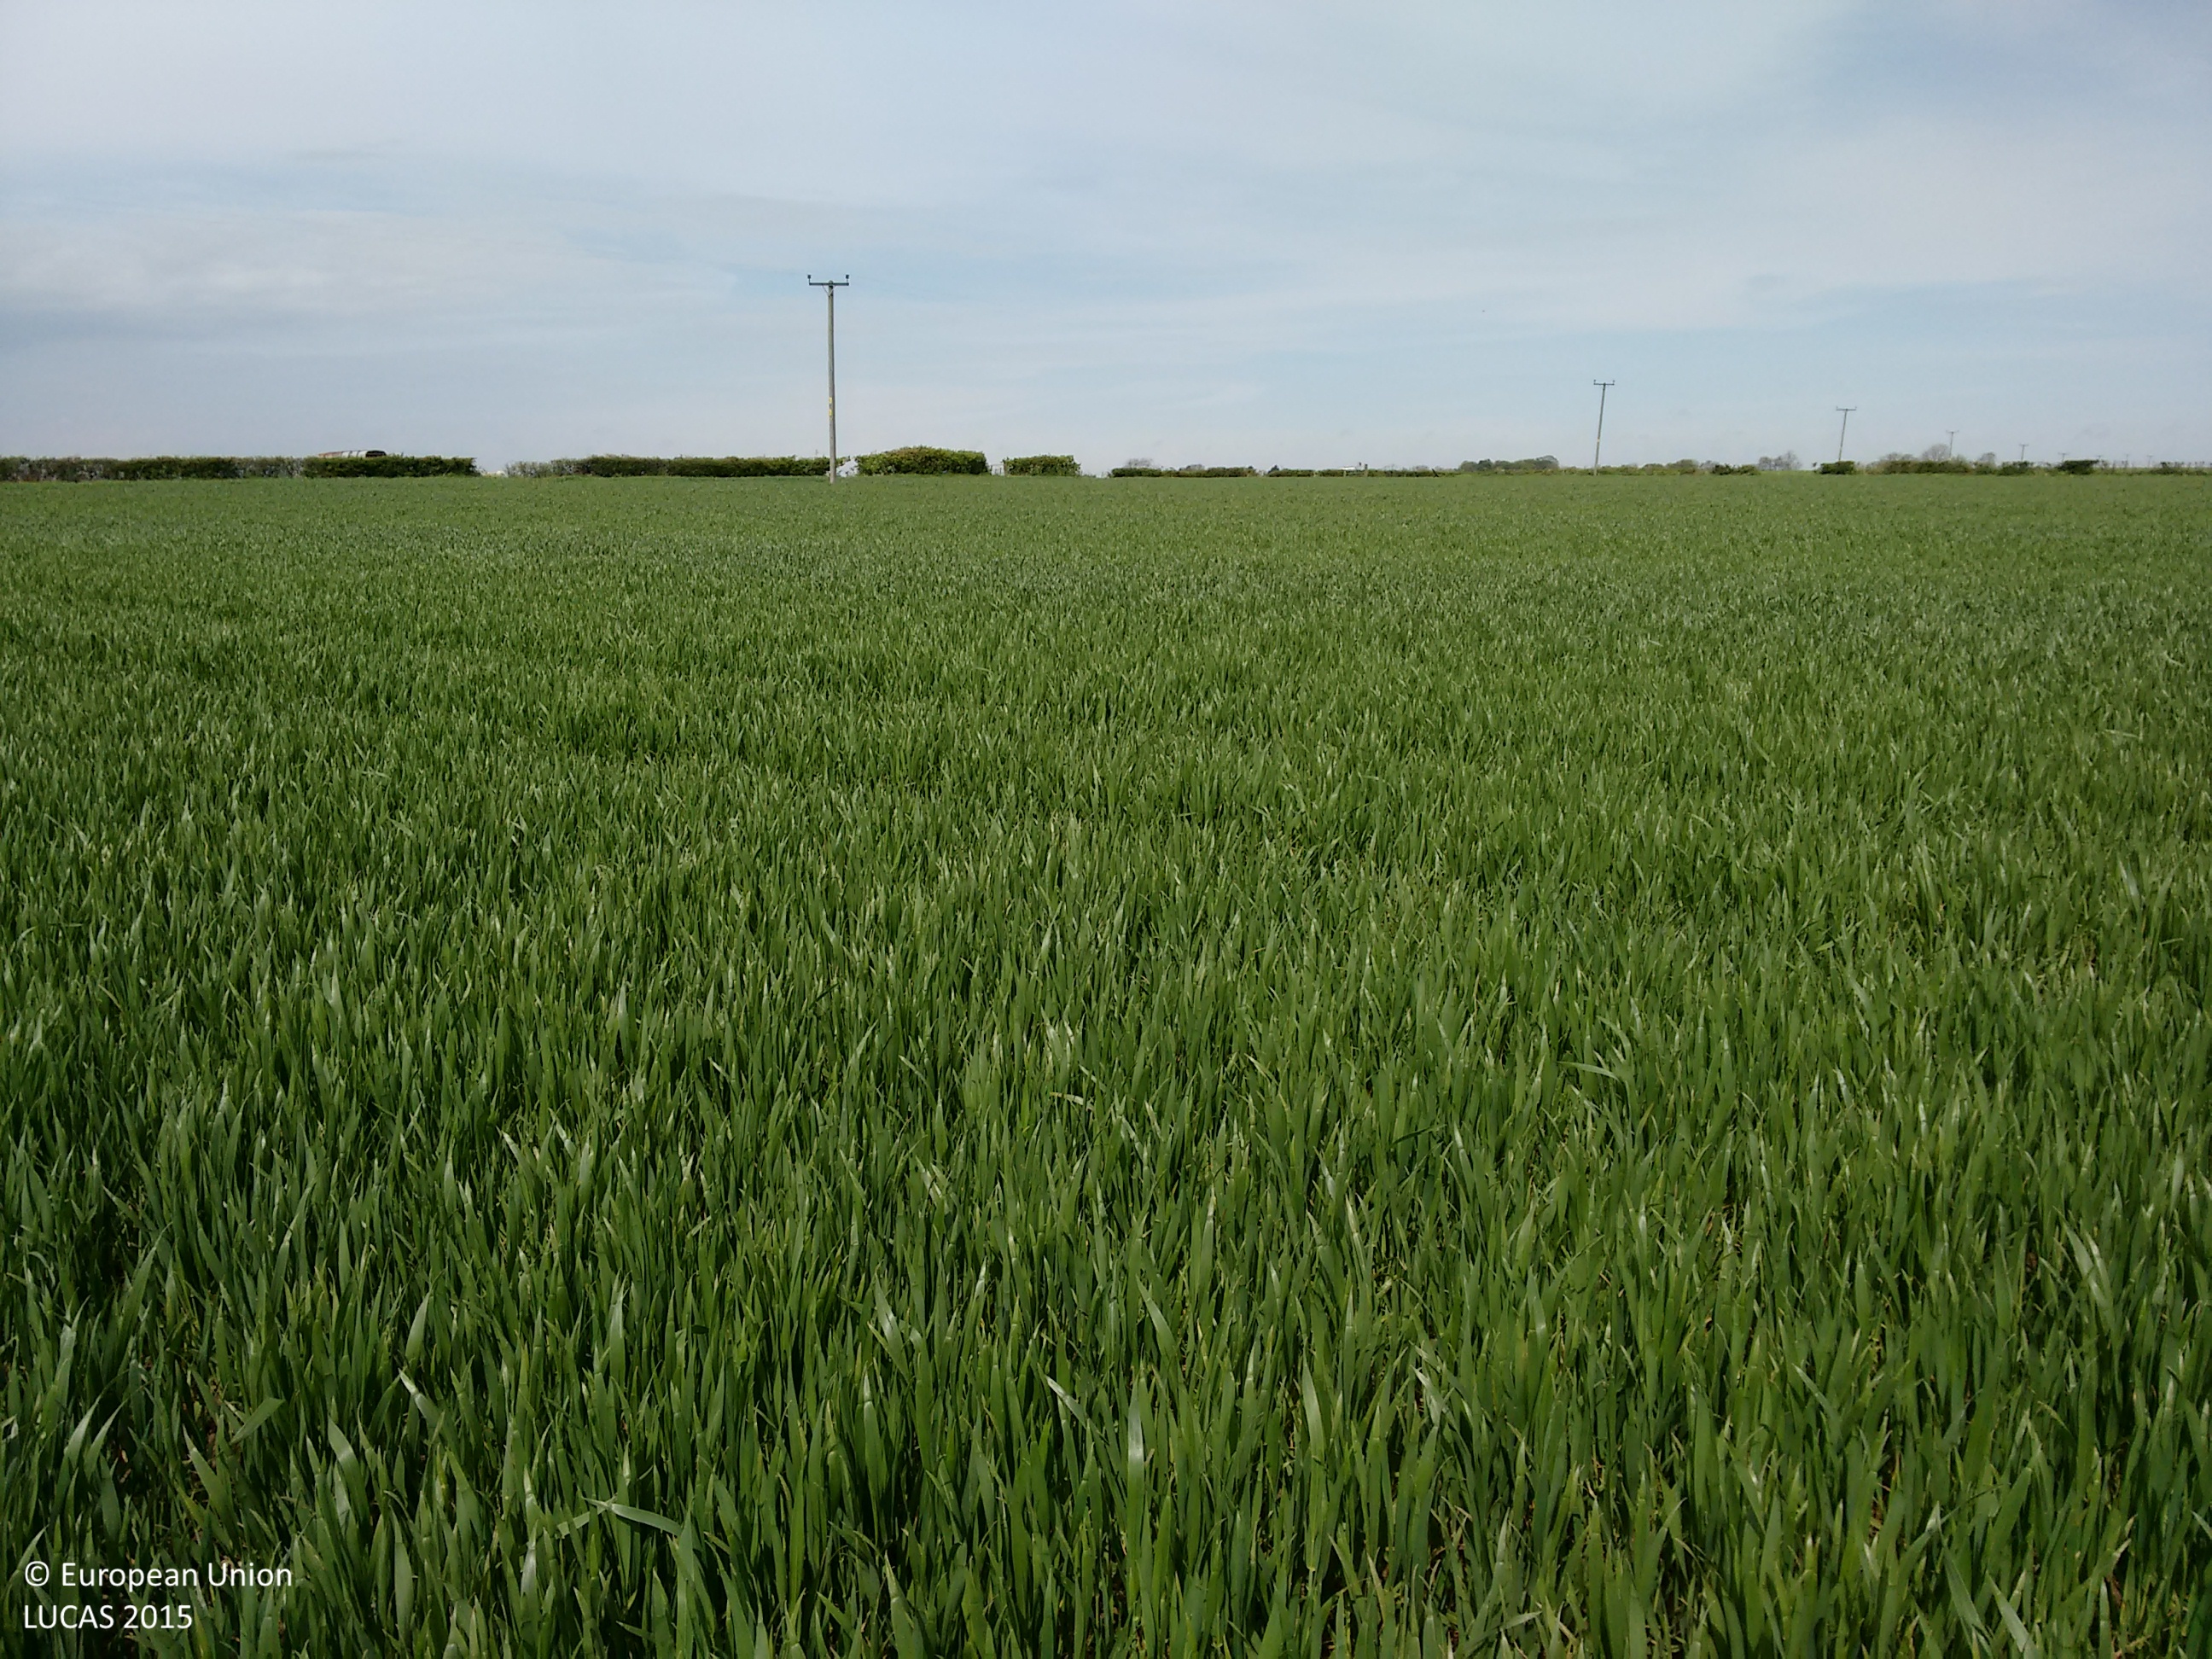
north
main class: Cropland
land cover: Common wheat
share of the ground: > 75 %
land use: Agriculture (excluding fallow land and kitchen gardens)
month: May
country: GB
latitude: 53.3244
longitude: 0.1357
